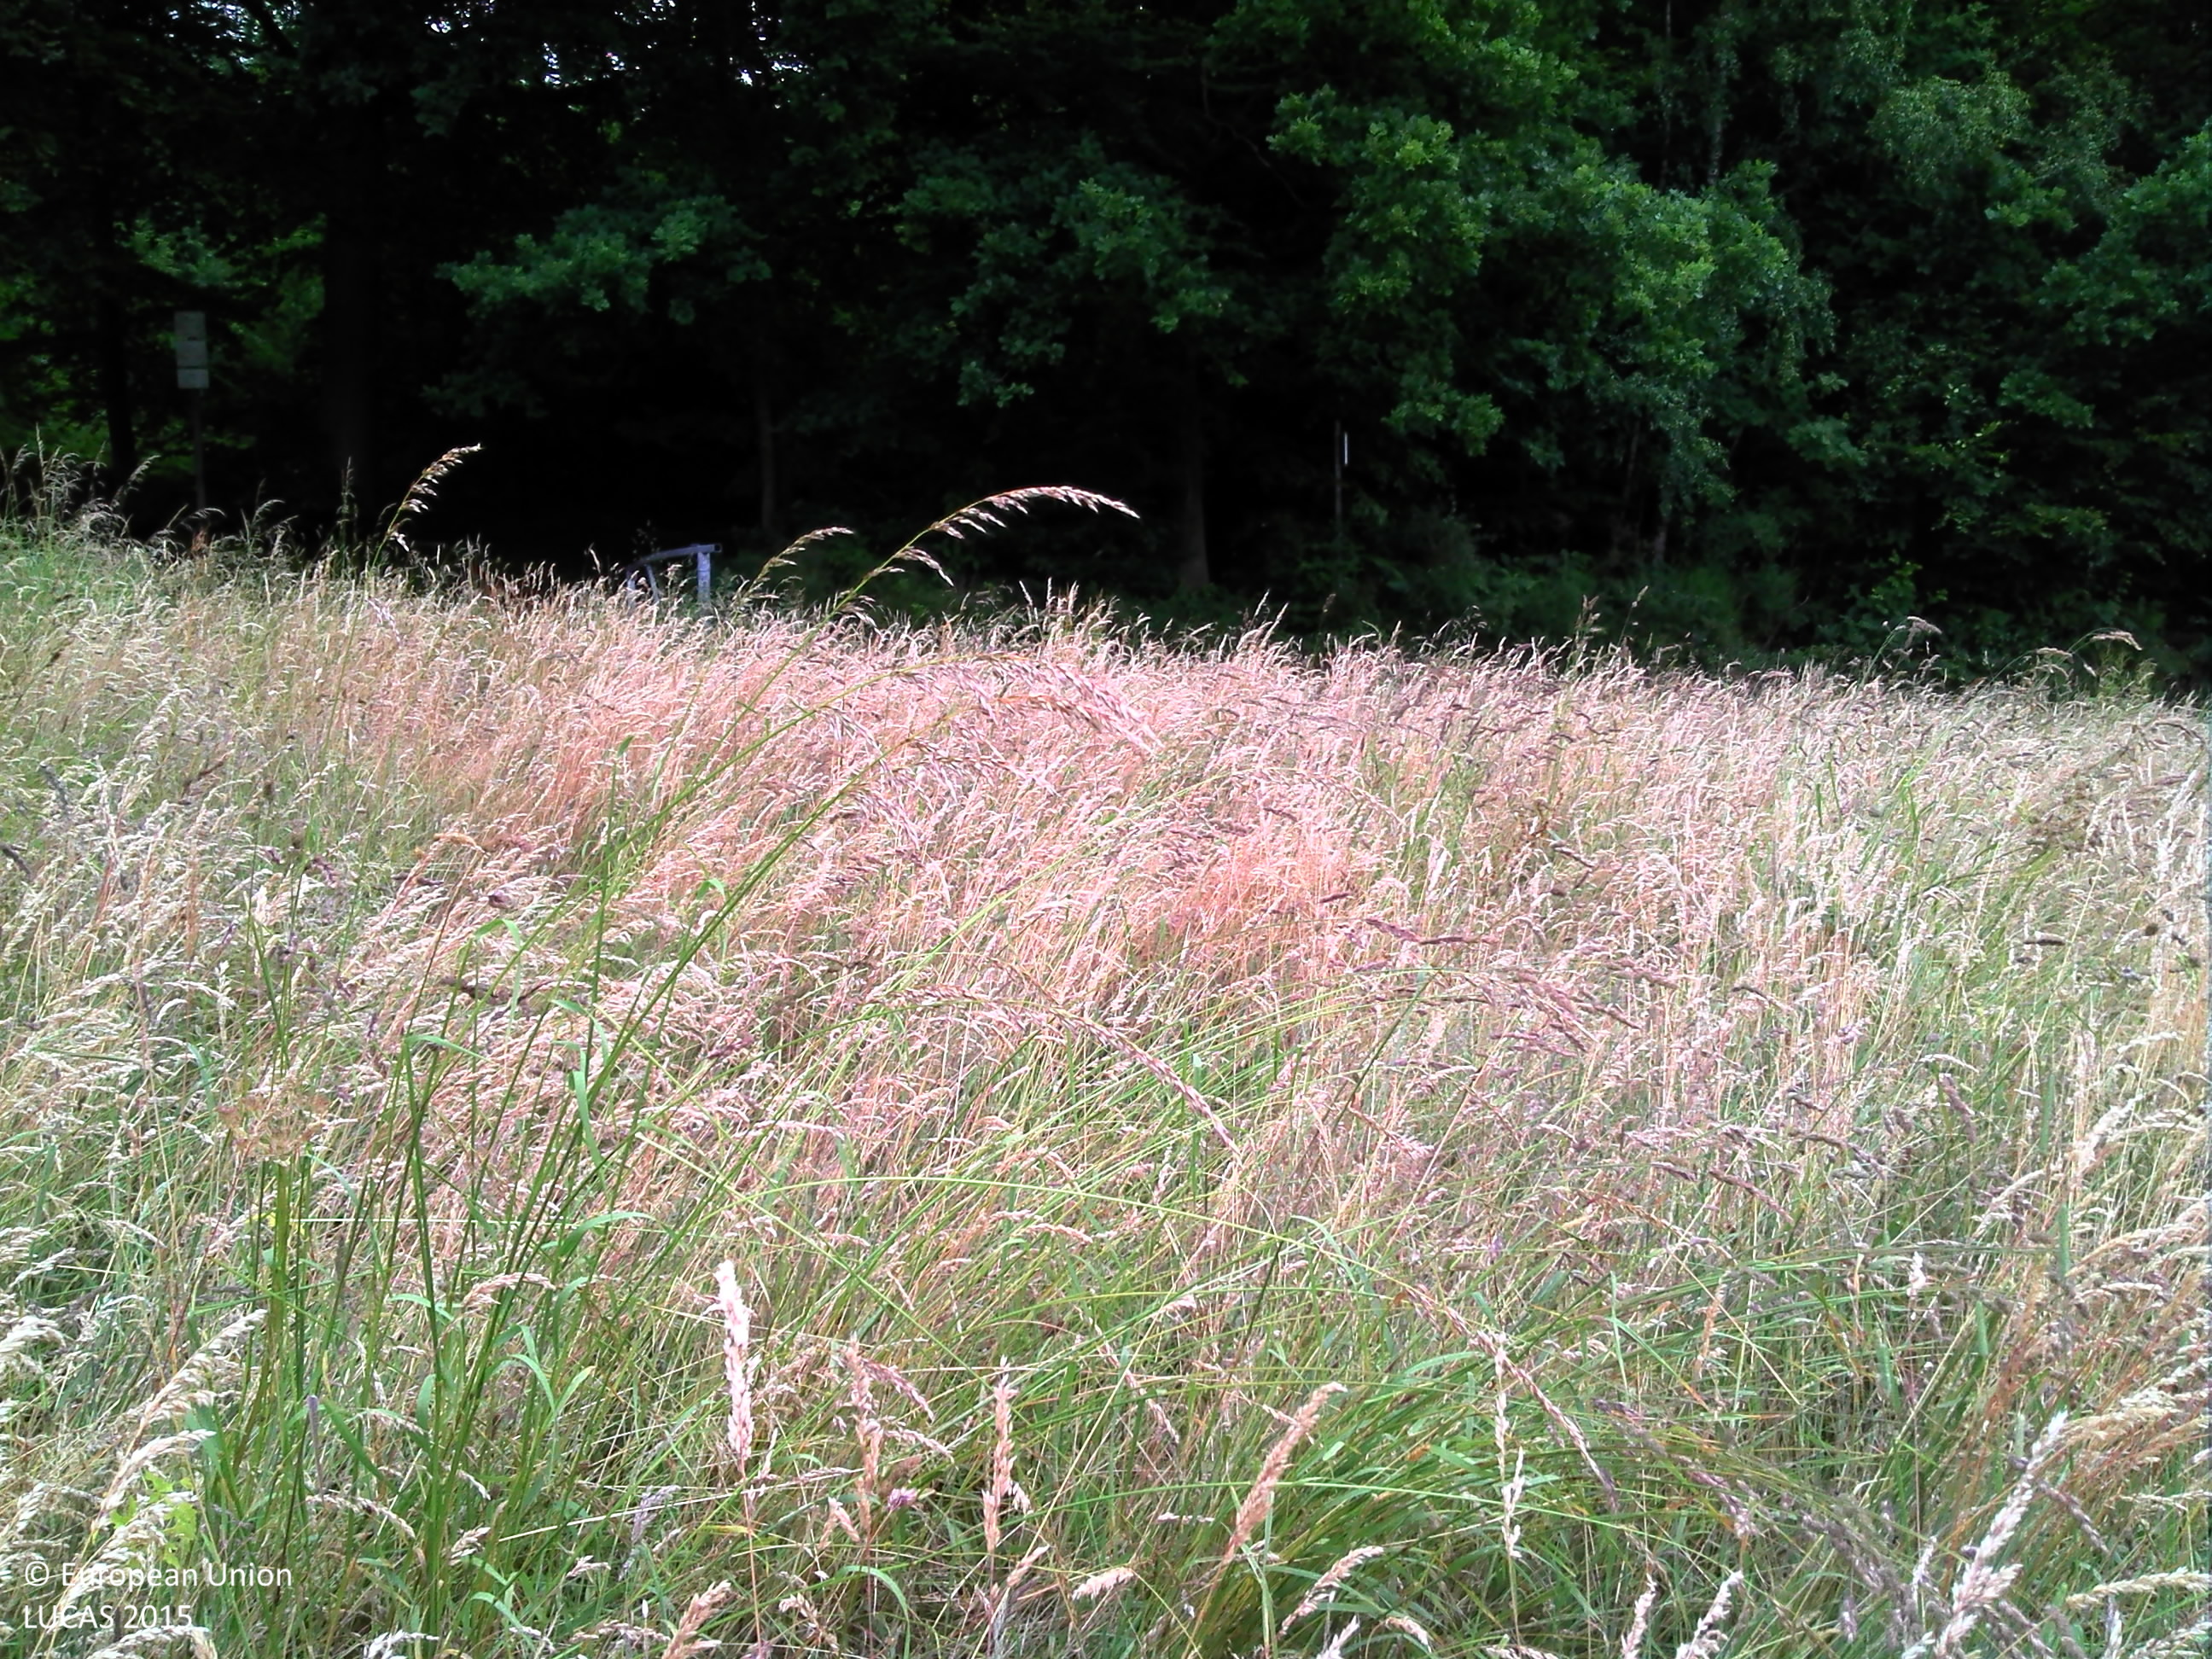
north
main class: Grassland
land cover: Grassland without tree/shrub cover
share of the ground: > 75 %
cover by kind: herbaceous plants 100 %
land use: Agriculture (excluding fallow land and kitchen gardens)
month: June
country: BE
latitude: 50.4928
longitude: 5.5298
